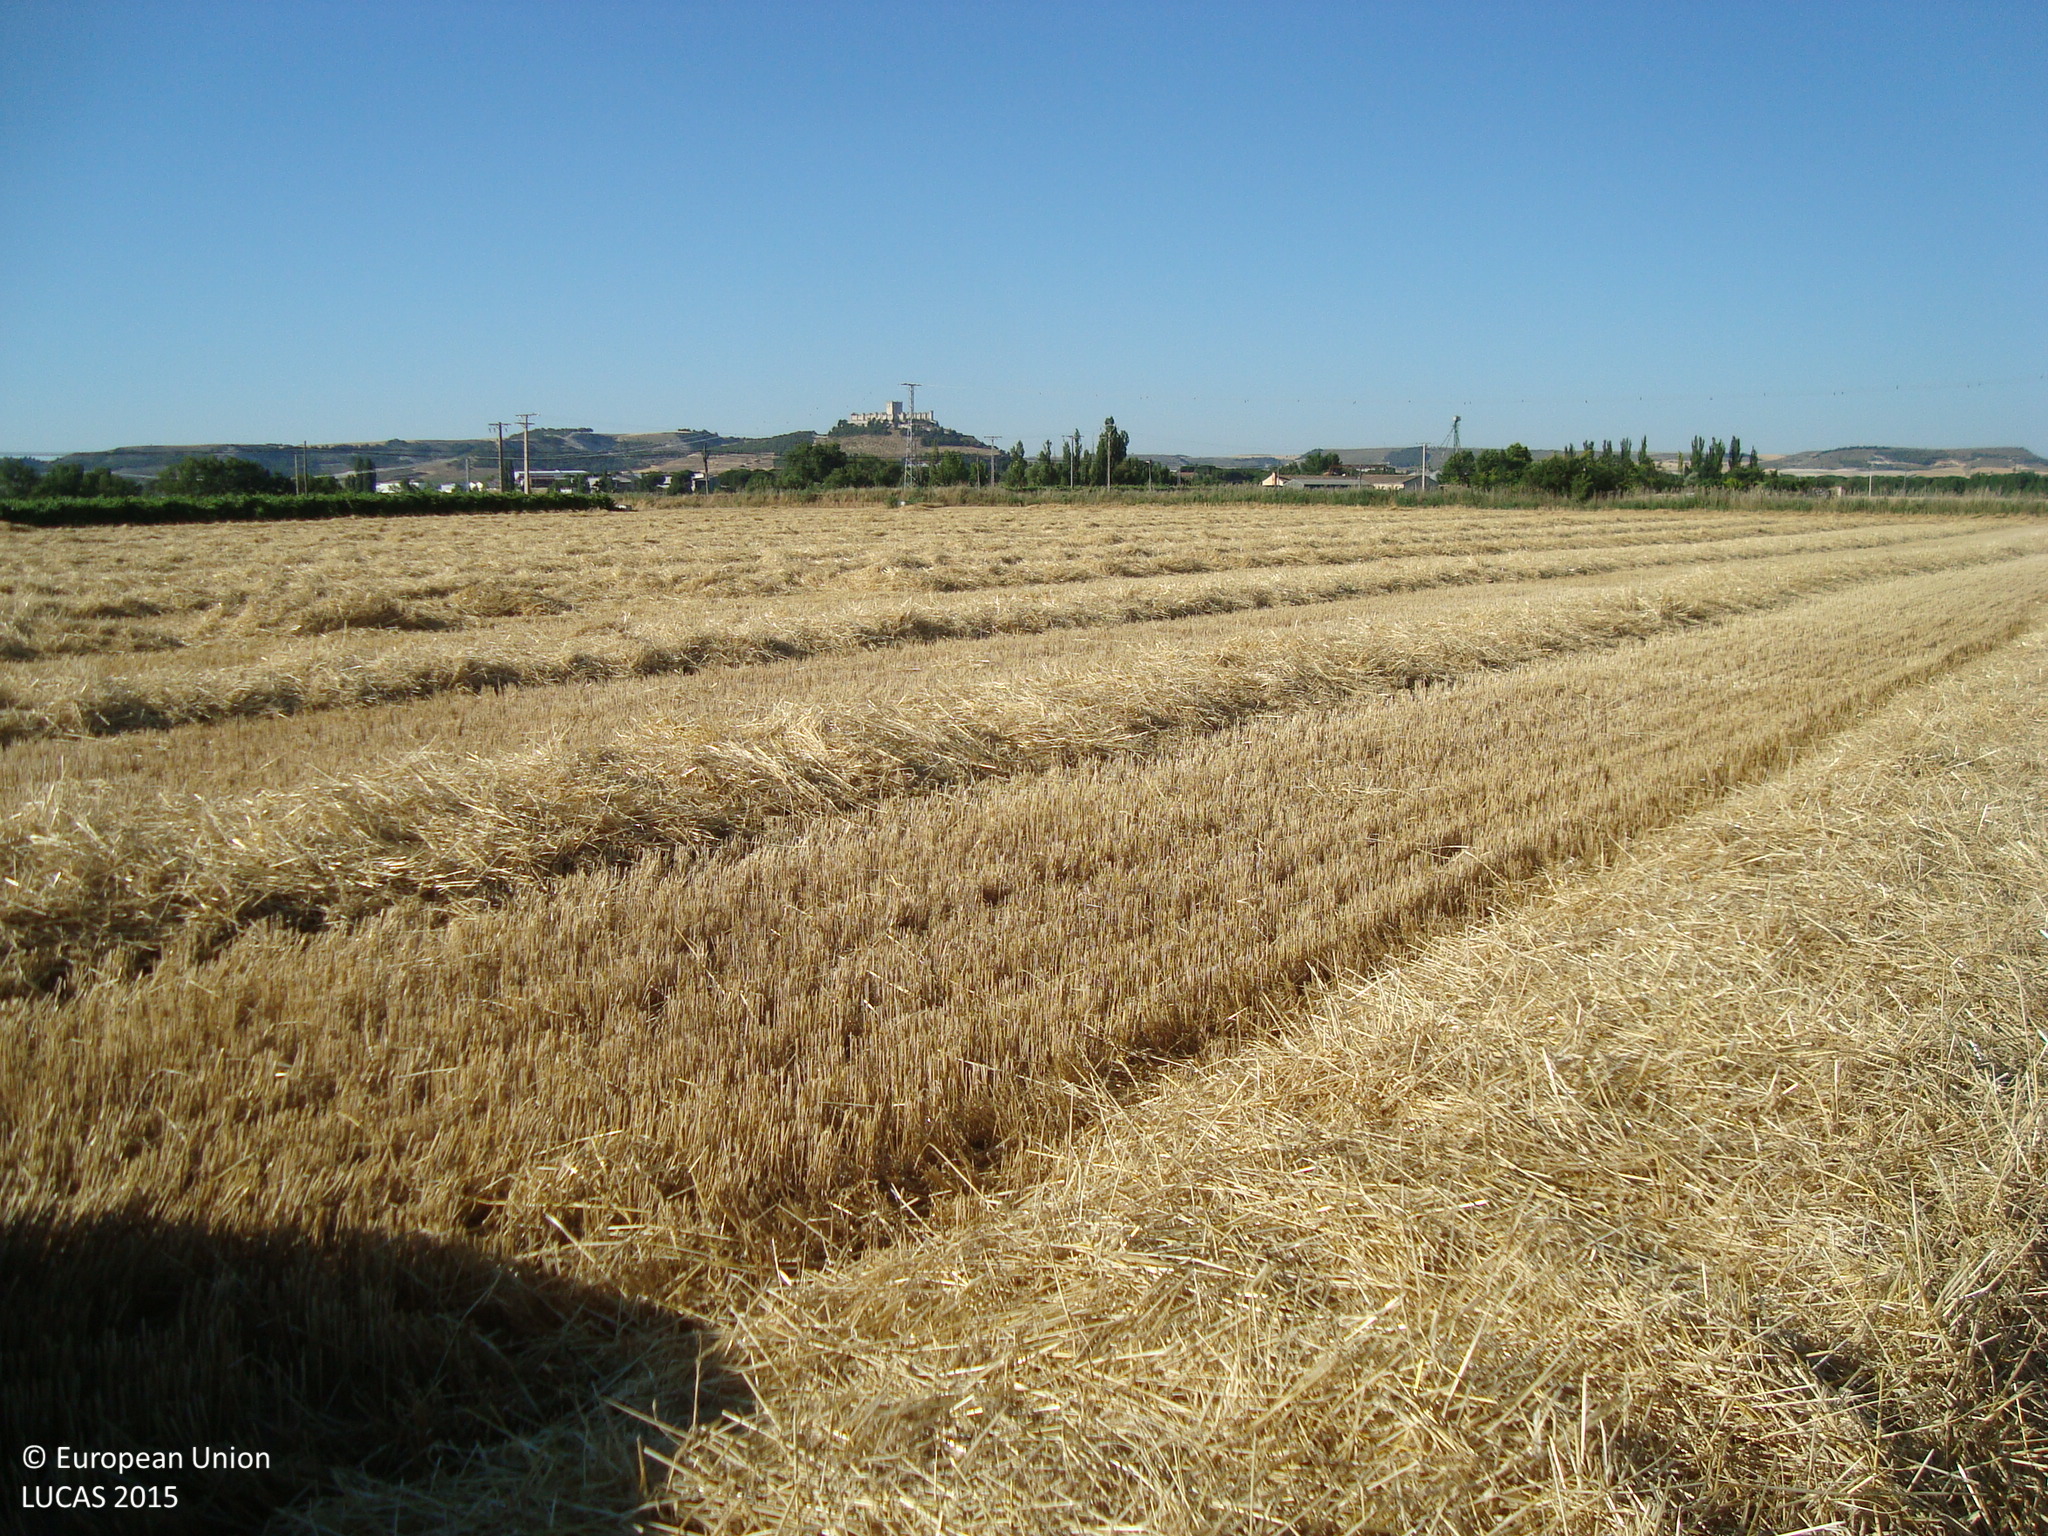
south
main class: Cropland
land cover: Barley
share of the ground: < 10 %
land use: Agriculture (excluding fallow land and kitchen gardens)
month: July
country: ES
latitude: 41.6236
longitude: -4.1133
